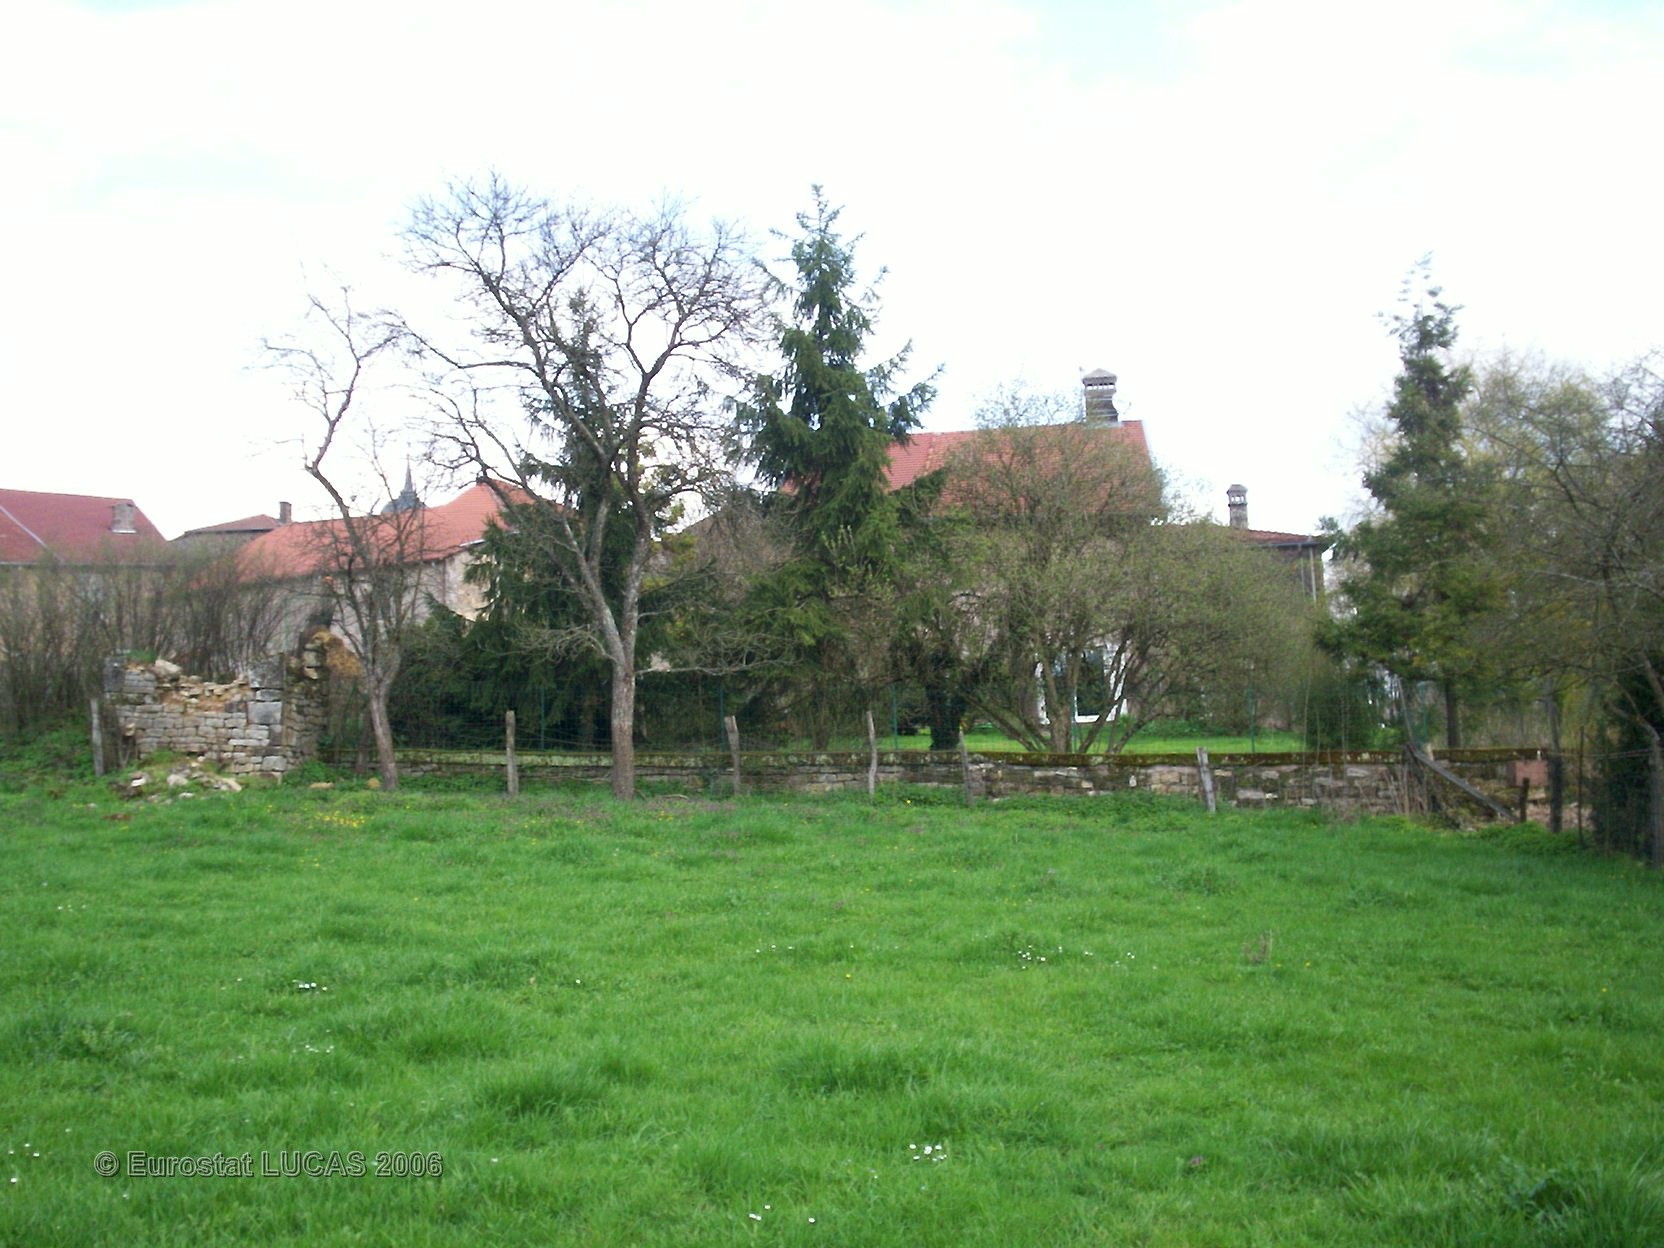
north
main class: Grassland
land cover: Grassland without tree/shrub cover
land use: Agriculture (excluding fallow land and kitchen gardens)
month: April
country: FR
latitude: 48.0595
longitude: 5.9617
